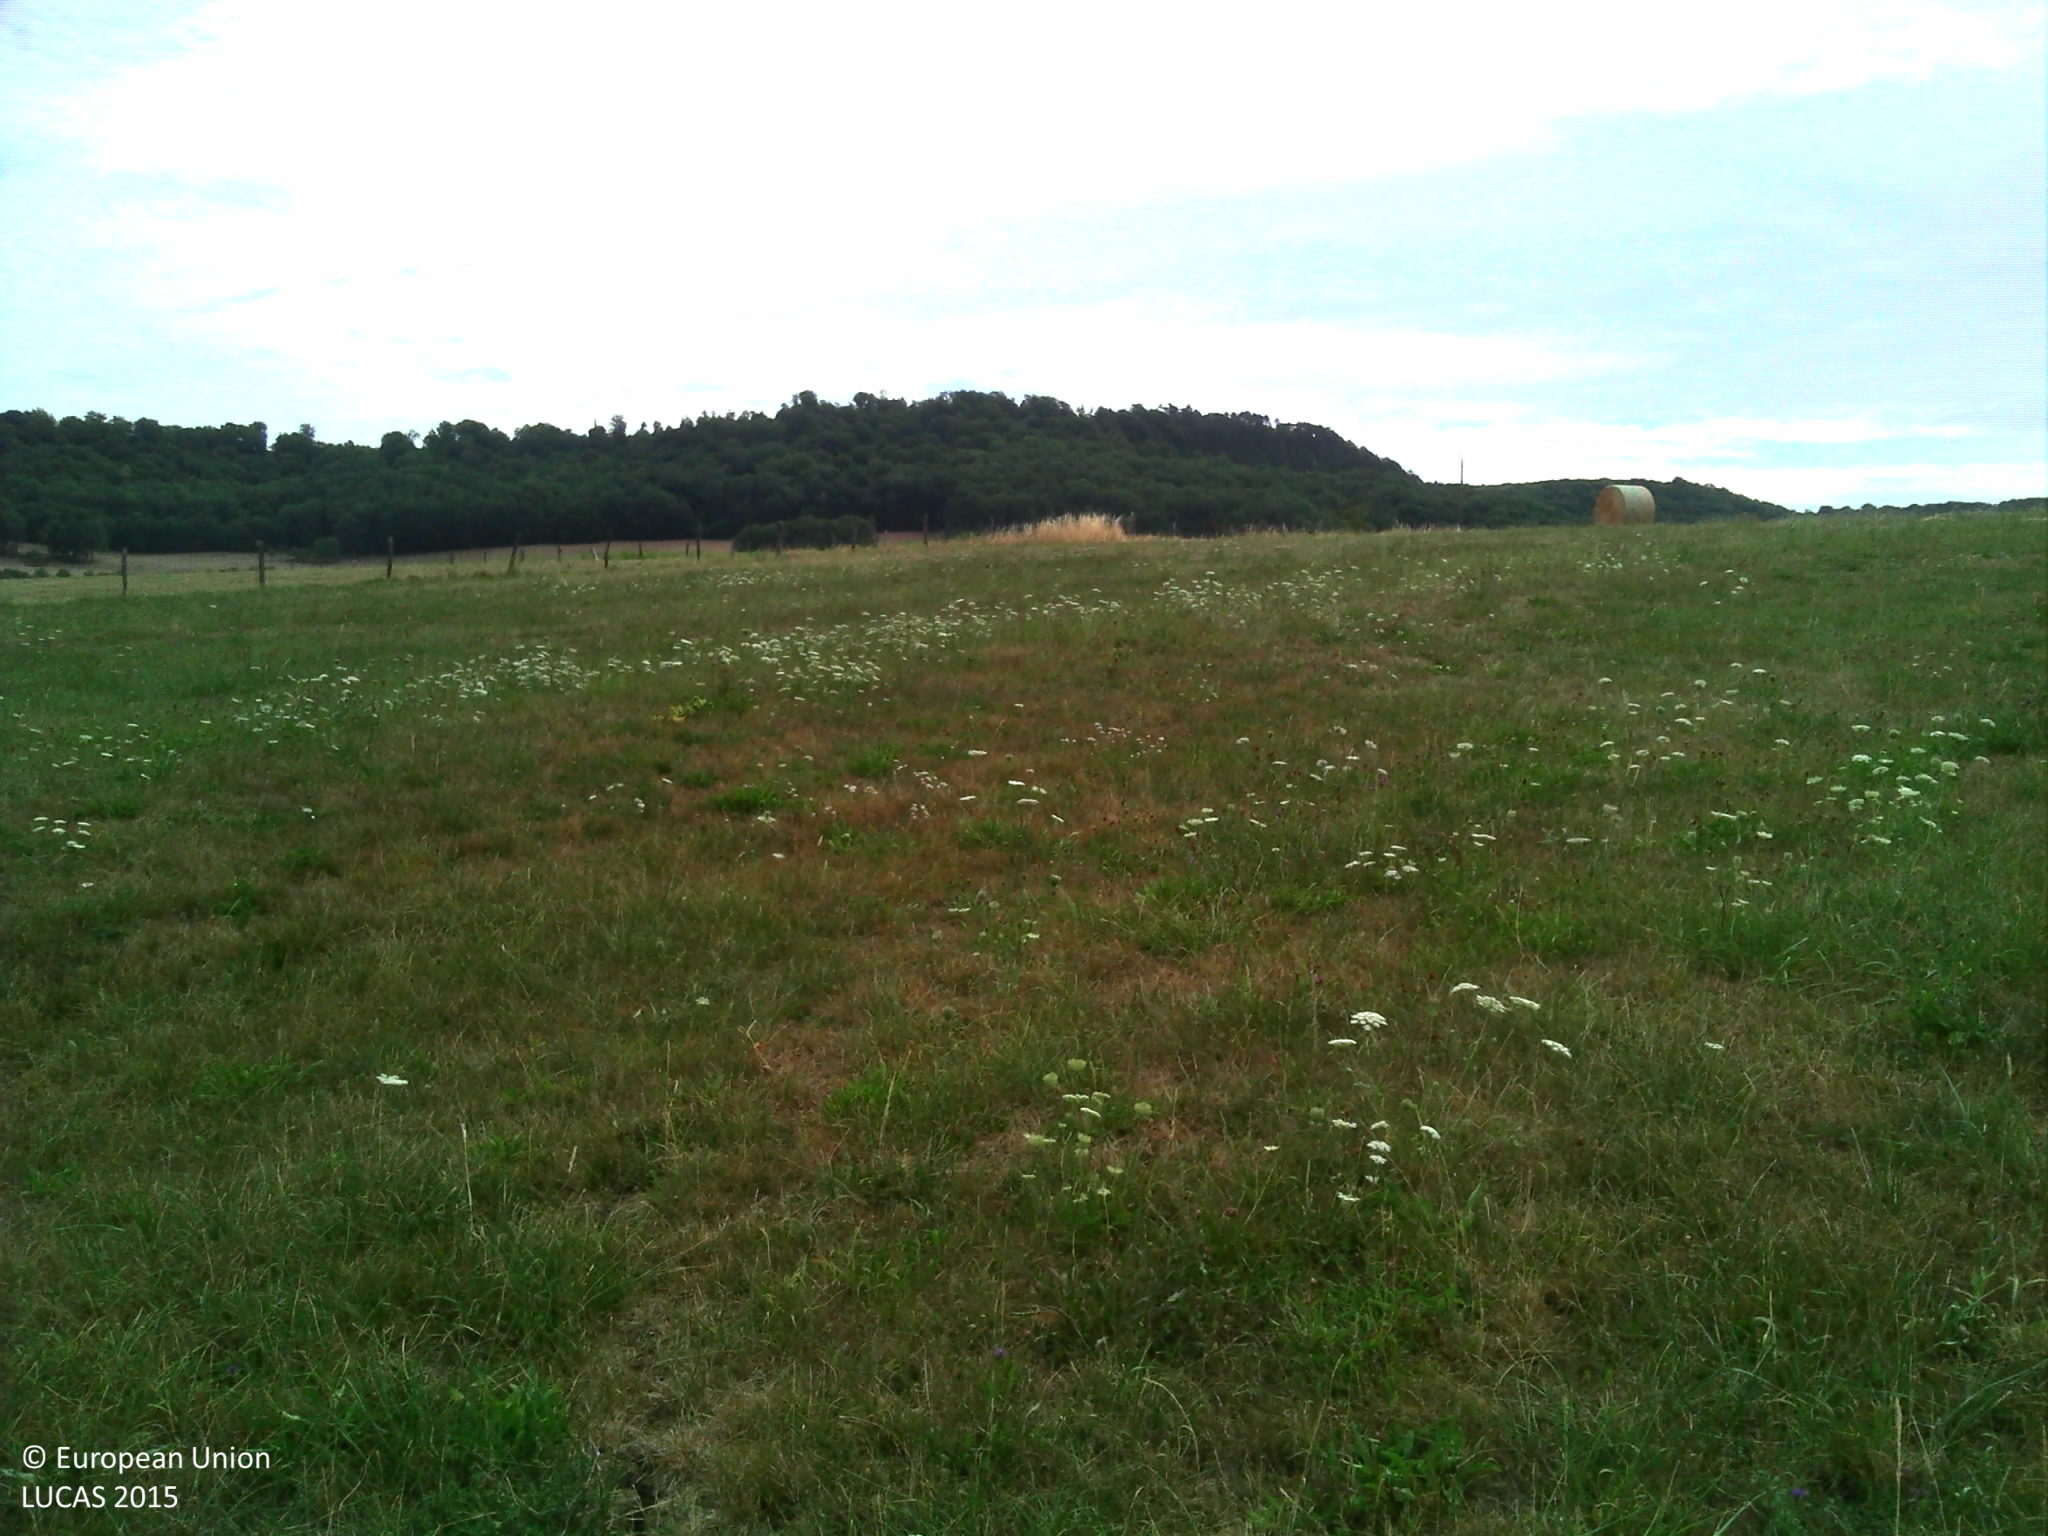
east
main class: Grassland
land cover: Grassland without tree/shrub cover
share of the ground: > 75 %
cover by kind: herbaceous plants 100 %
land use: Agriculture (excluding fallow land and kitchen gardens)
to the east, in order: Grassland without tree/shrub cover; Fences; Grassland without tree/shrub cover; Fences; Maize; Electric lines; Maize
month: July
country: FR
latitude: 48.4038
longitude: 6.0152
